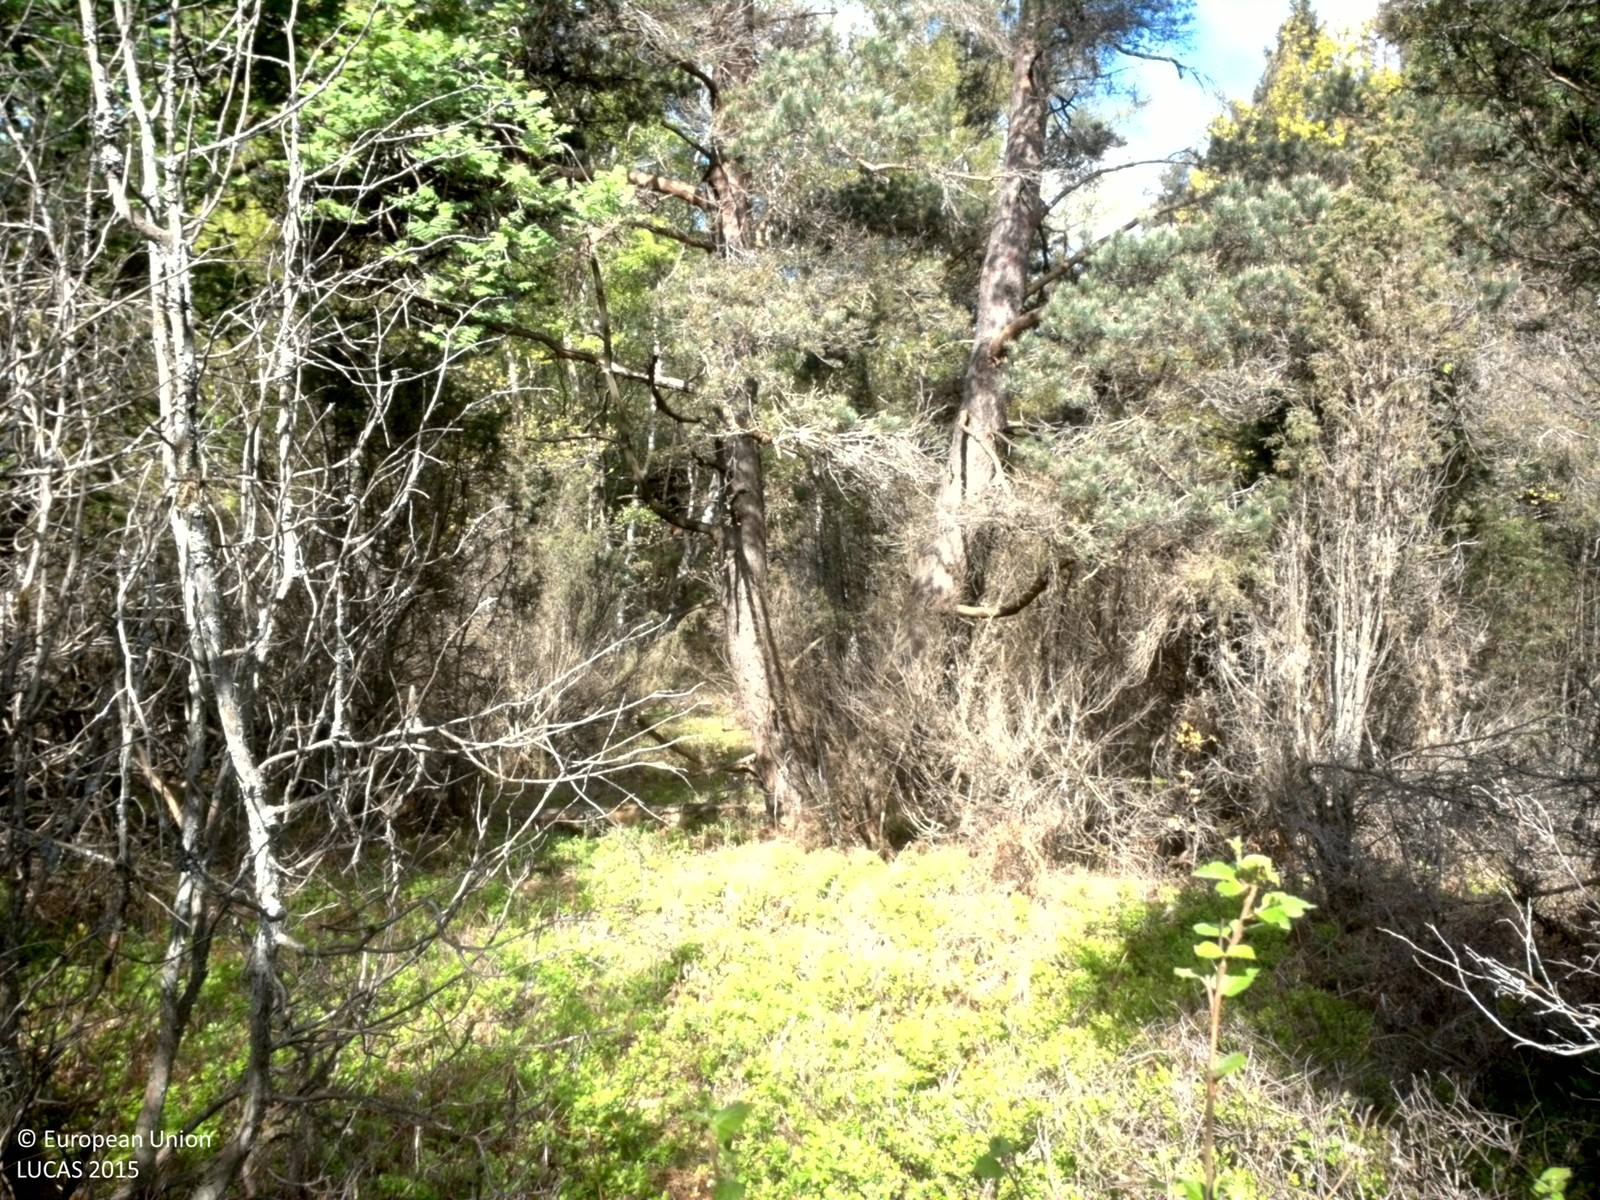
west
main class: Woodland
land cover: Pine dominated mixed woodland
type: boreal forest
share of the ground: 50 - 75 %
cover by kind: coniferous forest trees 50 %, broadleaved forest trees 25 %, shrubs 15 %, herbaceous plants 10 %
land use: Amenities, museums, leisure
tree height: > 5 m
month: May
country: SE
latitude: 57.6116
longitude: 11.9552
